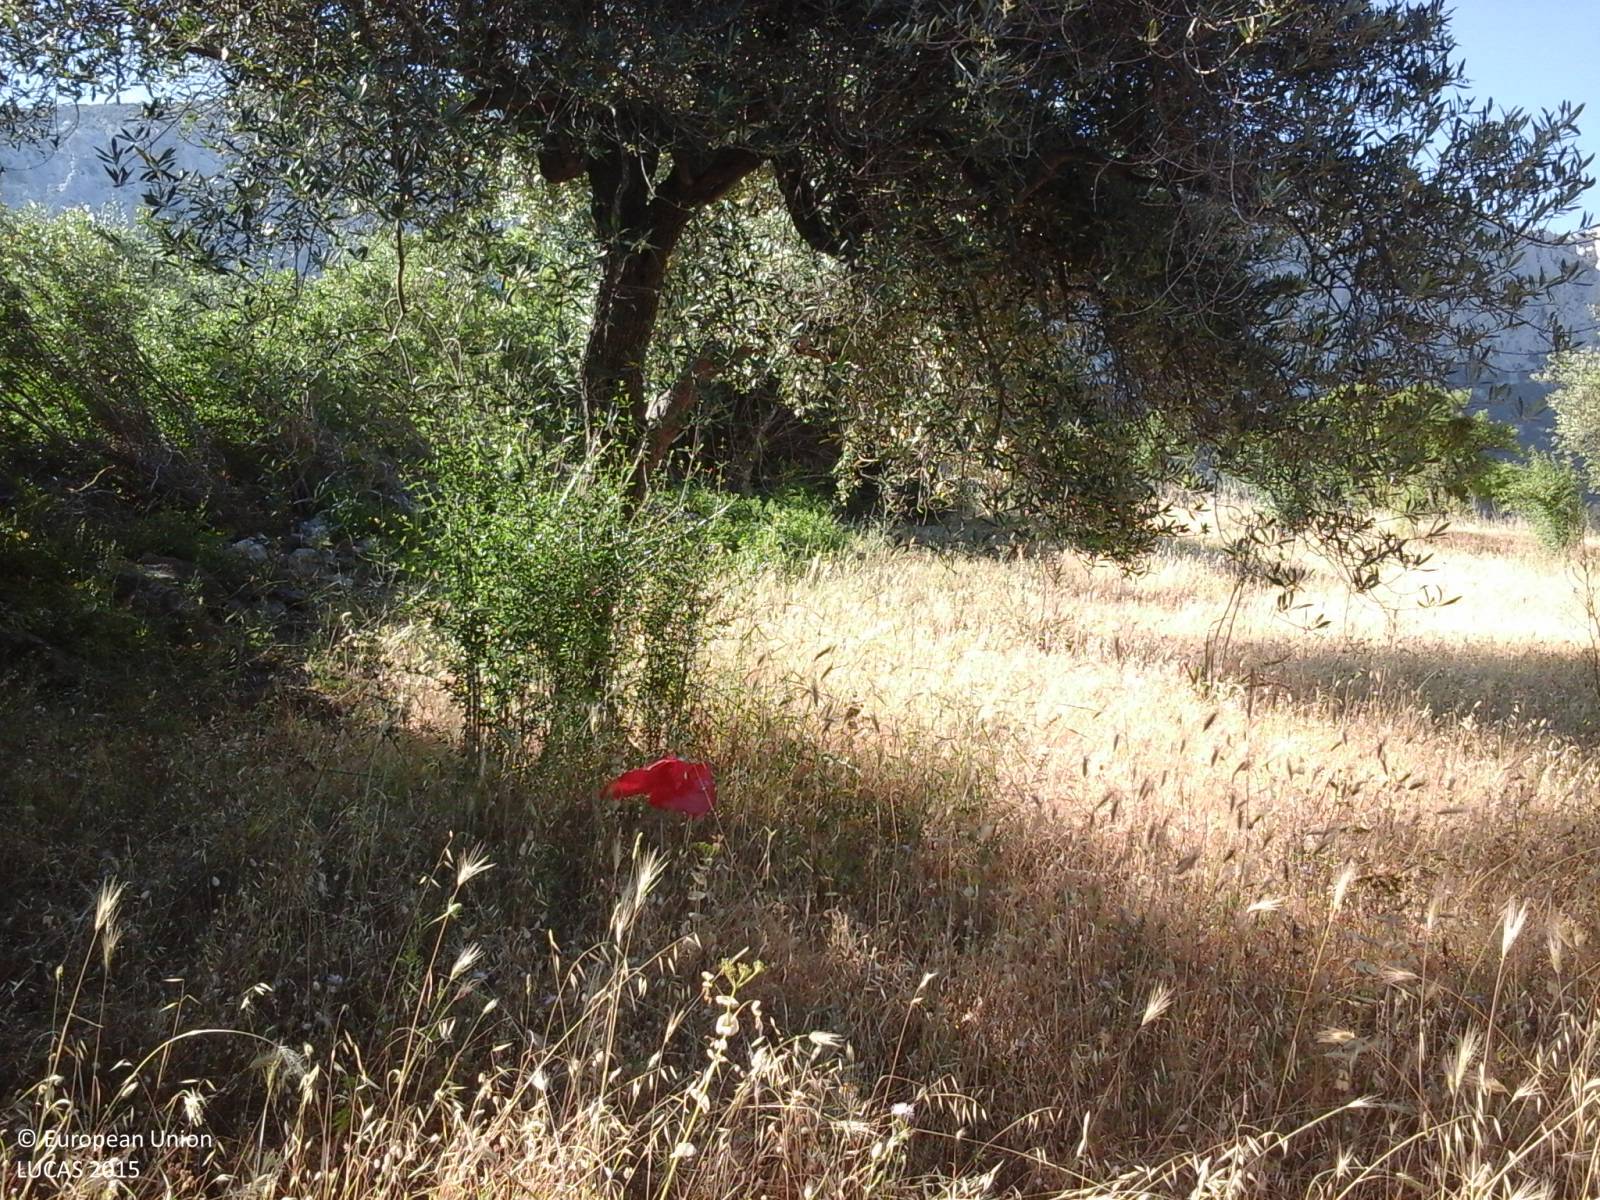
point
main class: Cropland
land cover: Olive groves
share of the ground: > 75 %
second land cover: Grassland without tree/shrub cover
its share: > 75 %
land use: Agriculture (excluding fallow land and kitchen gardens)
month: May
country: IT
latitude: 40.2840
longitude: 9.4735
